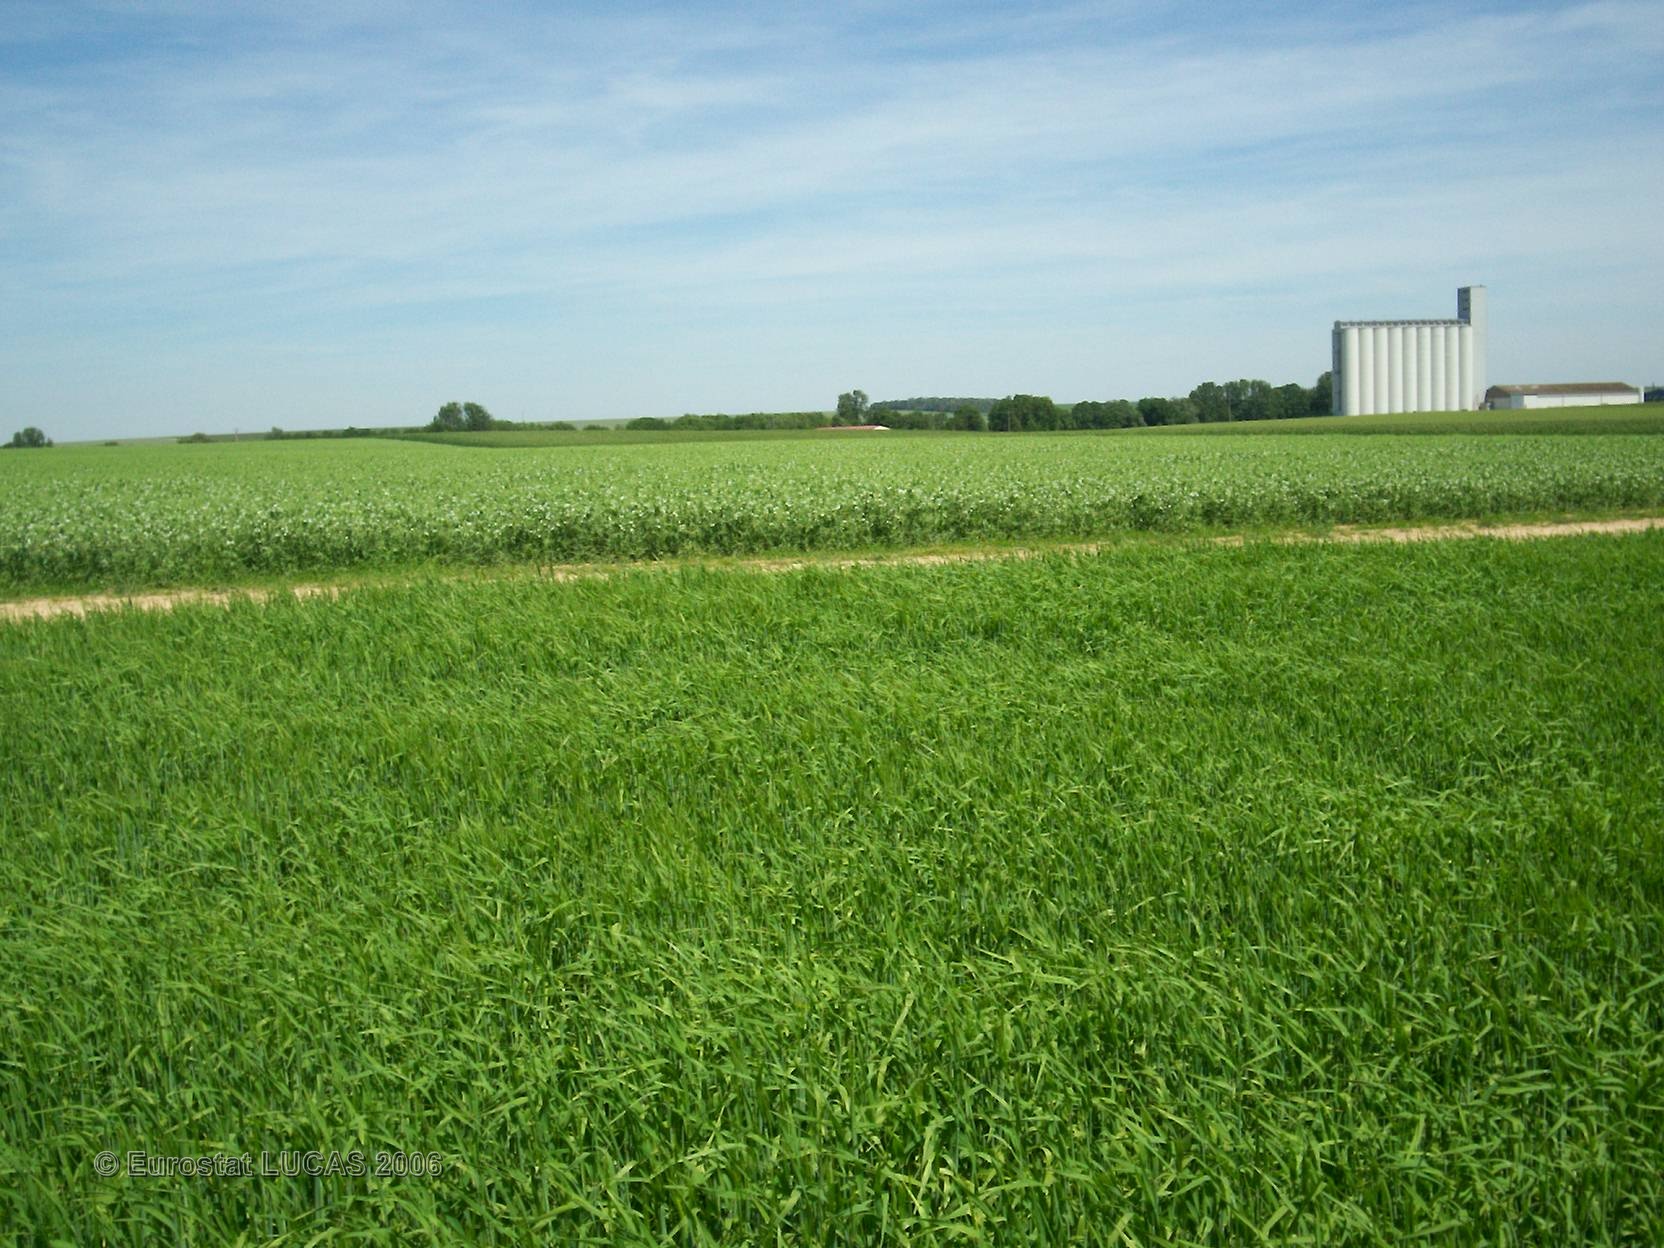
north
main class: Cropland
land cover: Barley
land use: Agriculture (excluding fallow land and kitchen gardens)
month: June
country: FR
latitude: 49.0465
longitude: 4.5926
